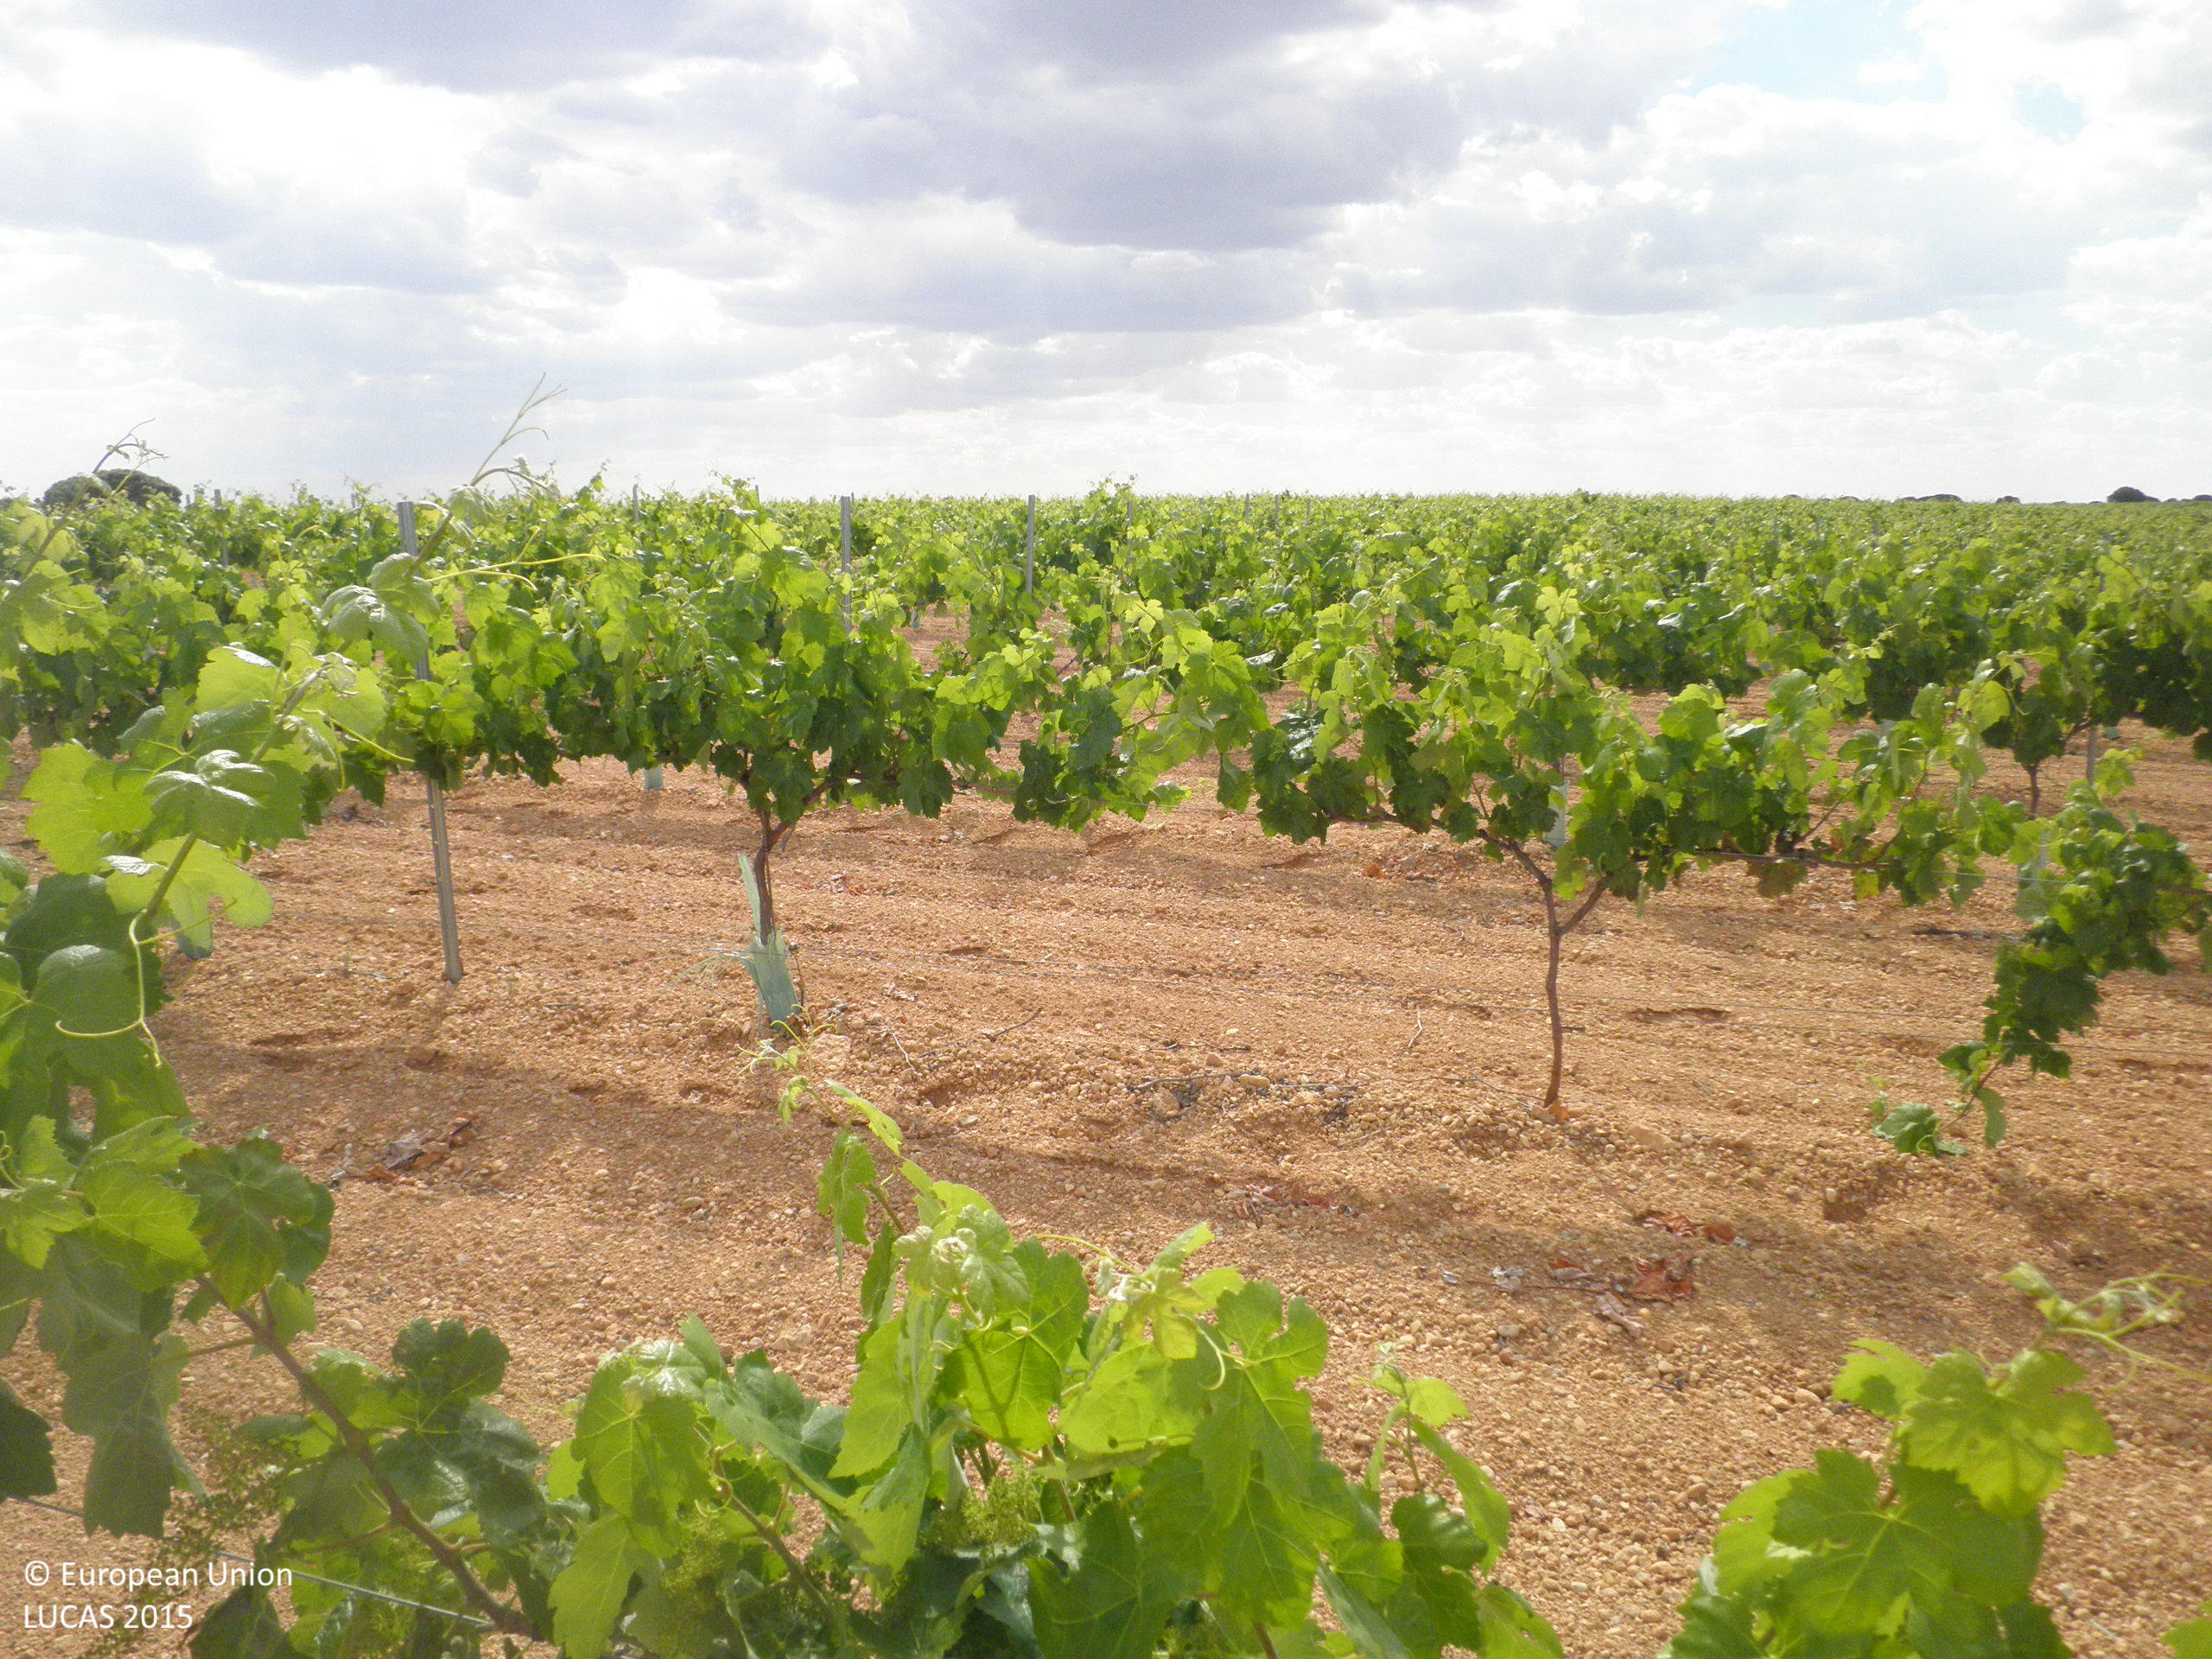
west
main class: Cropland
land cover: Vineyards
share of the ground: < 10 %
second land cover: Other bare soil
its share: > 75 %
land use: Agriculture (excluding fallow land and kitchen gardens)
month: June
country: ES
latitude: 39.4760
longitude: -1.8287
